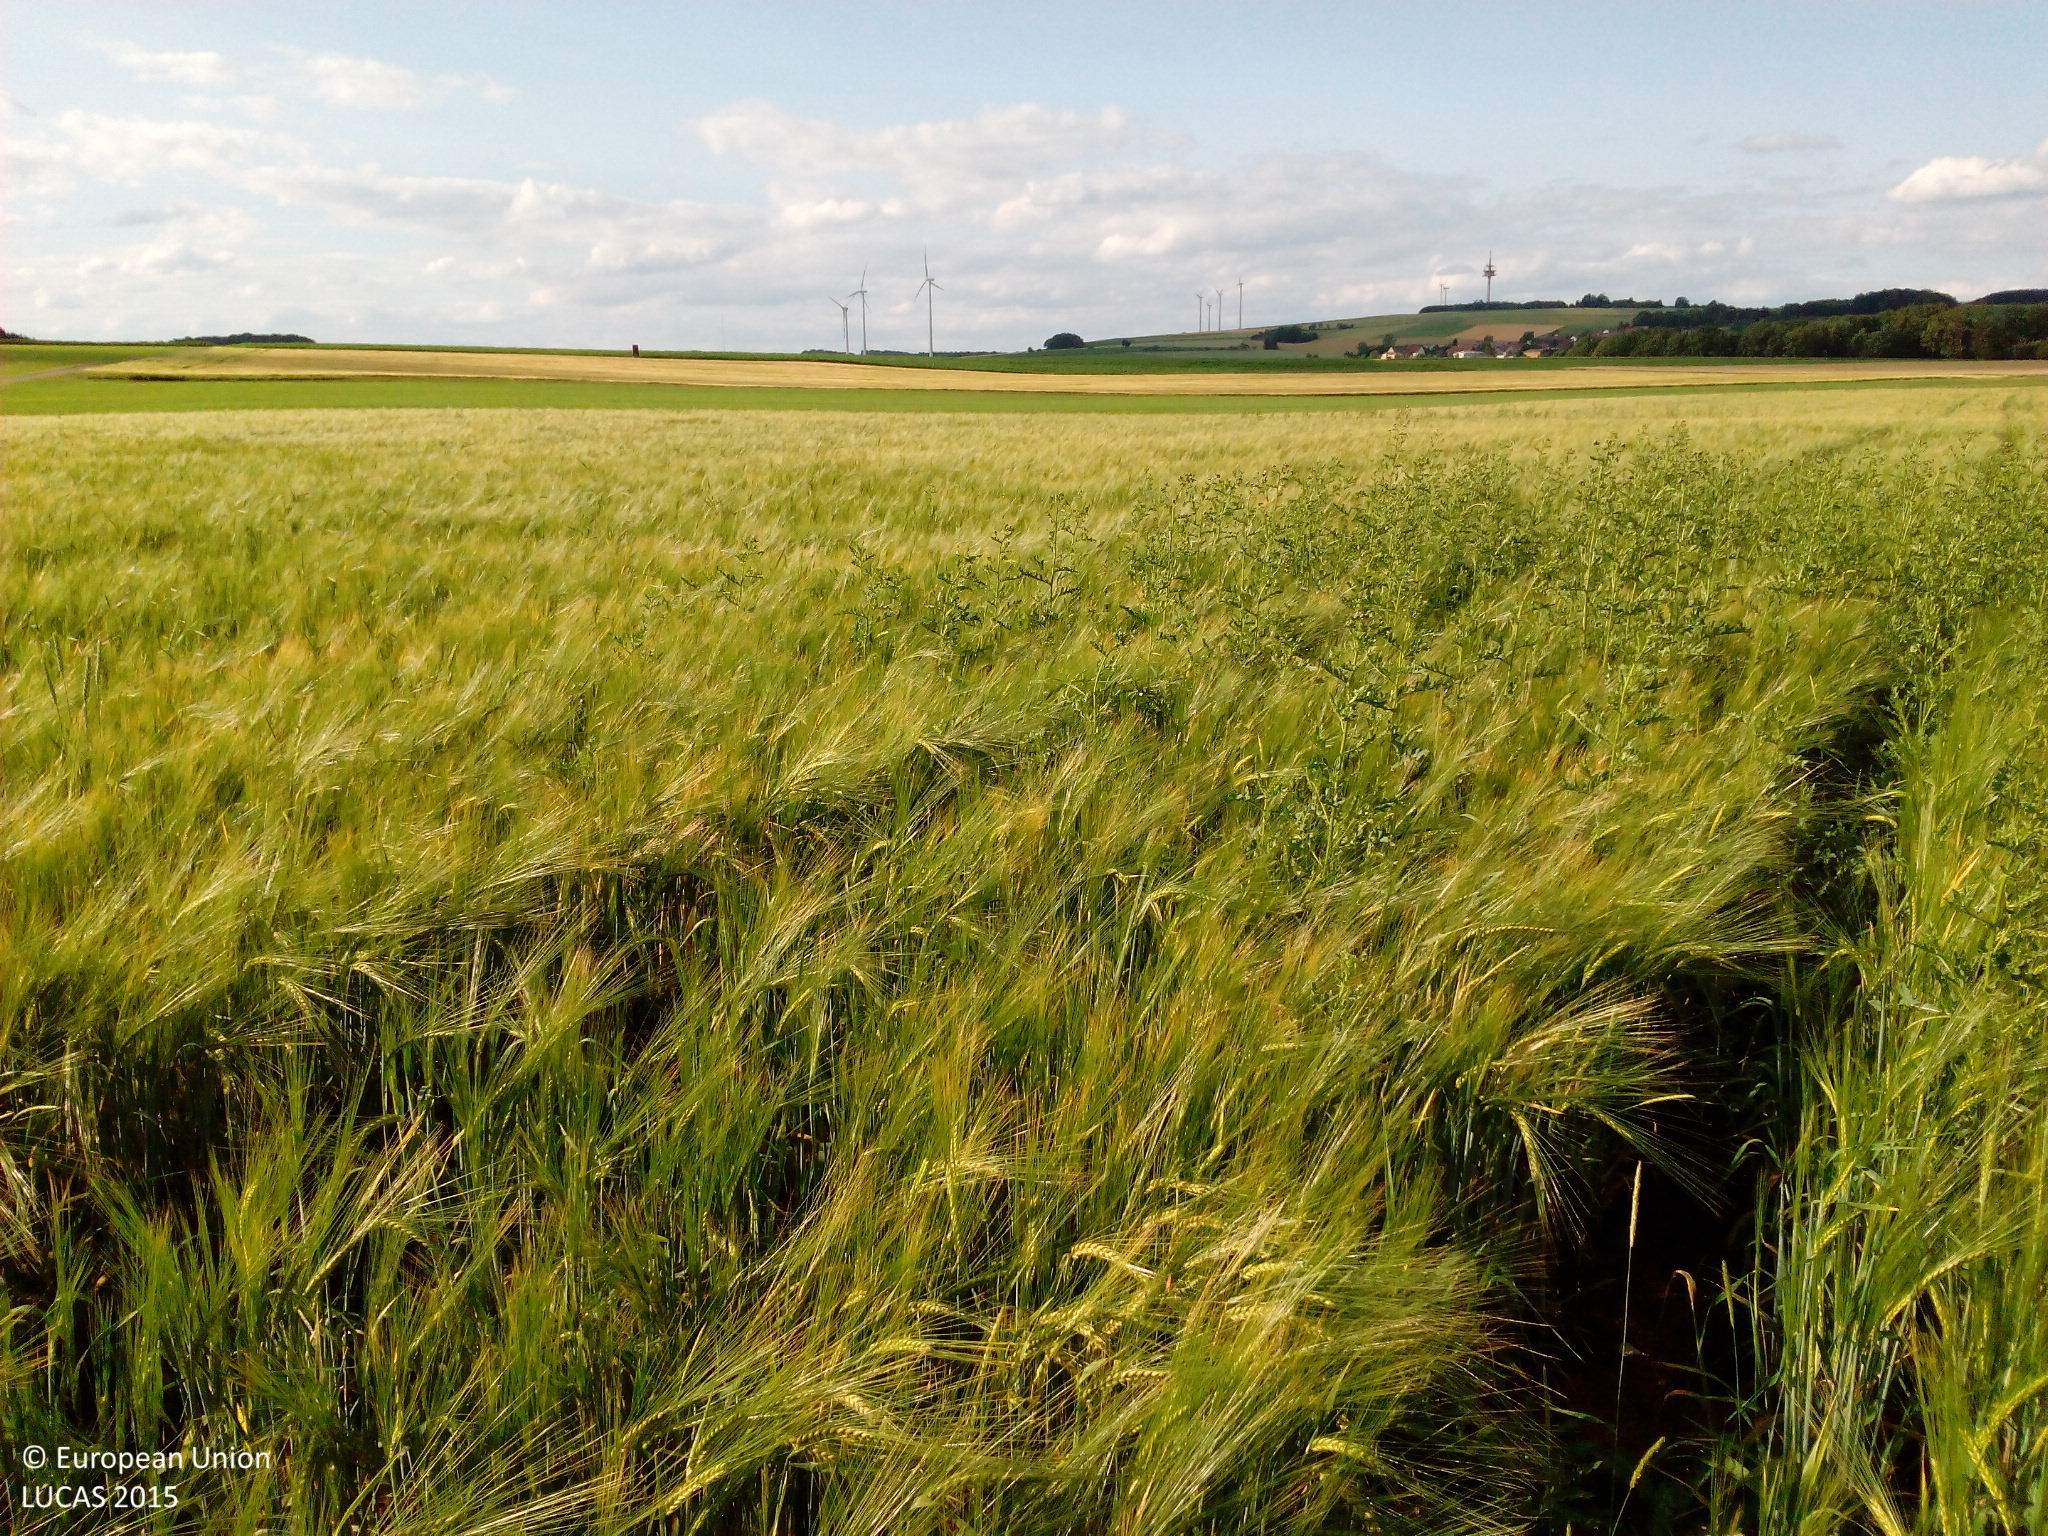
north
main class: Cropland
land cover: Barley
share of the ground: > 75 %
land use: Agriculture (excluding fallow land and kitchen gardens)
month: July
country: DE
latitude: 48.6373
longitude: 9.8508
